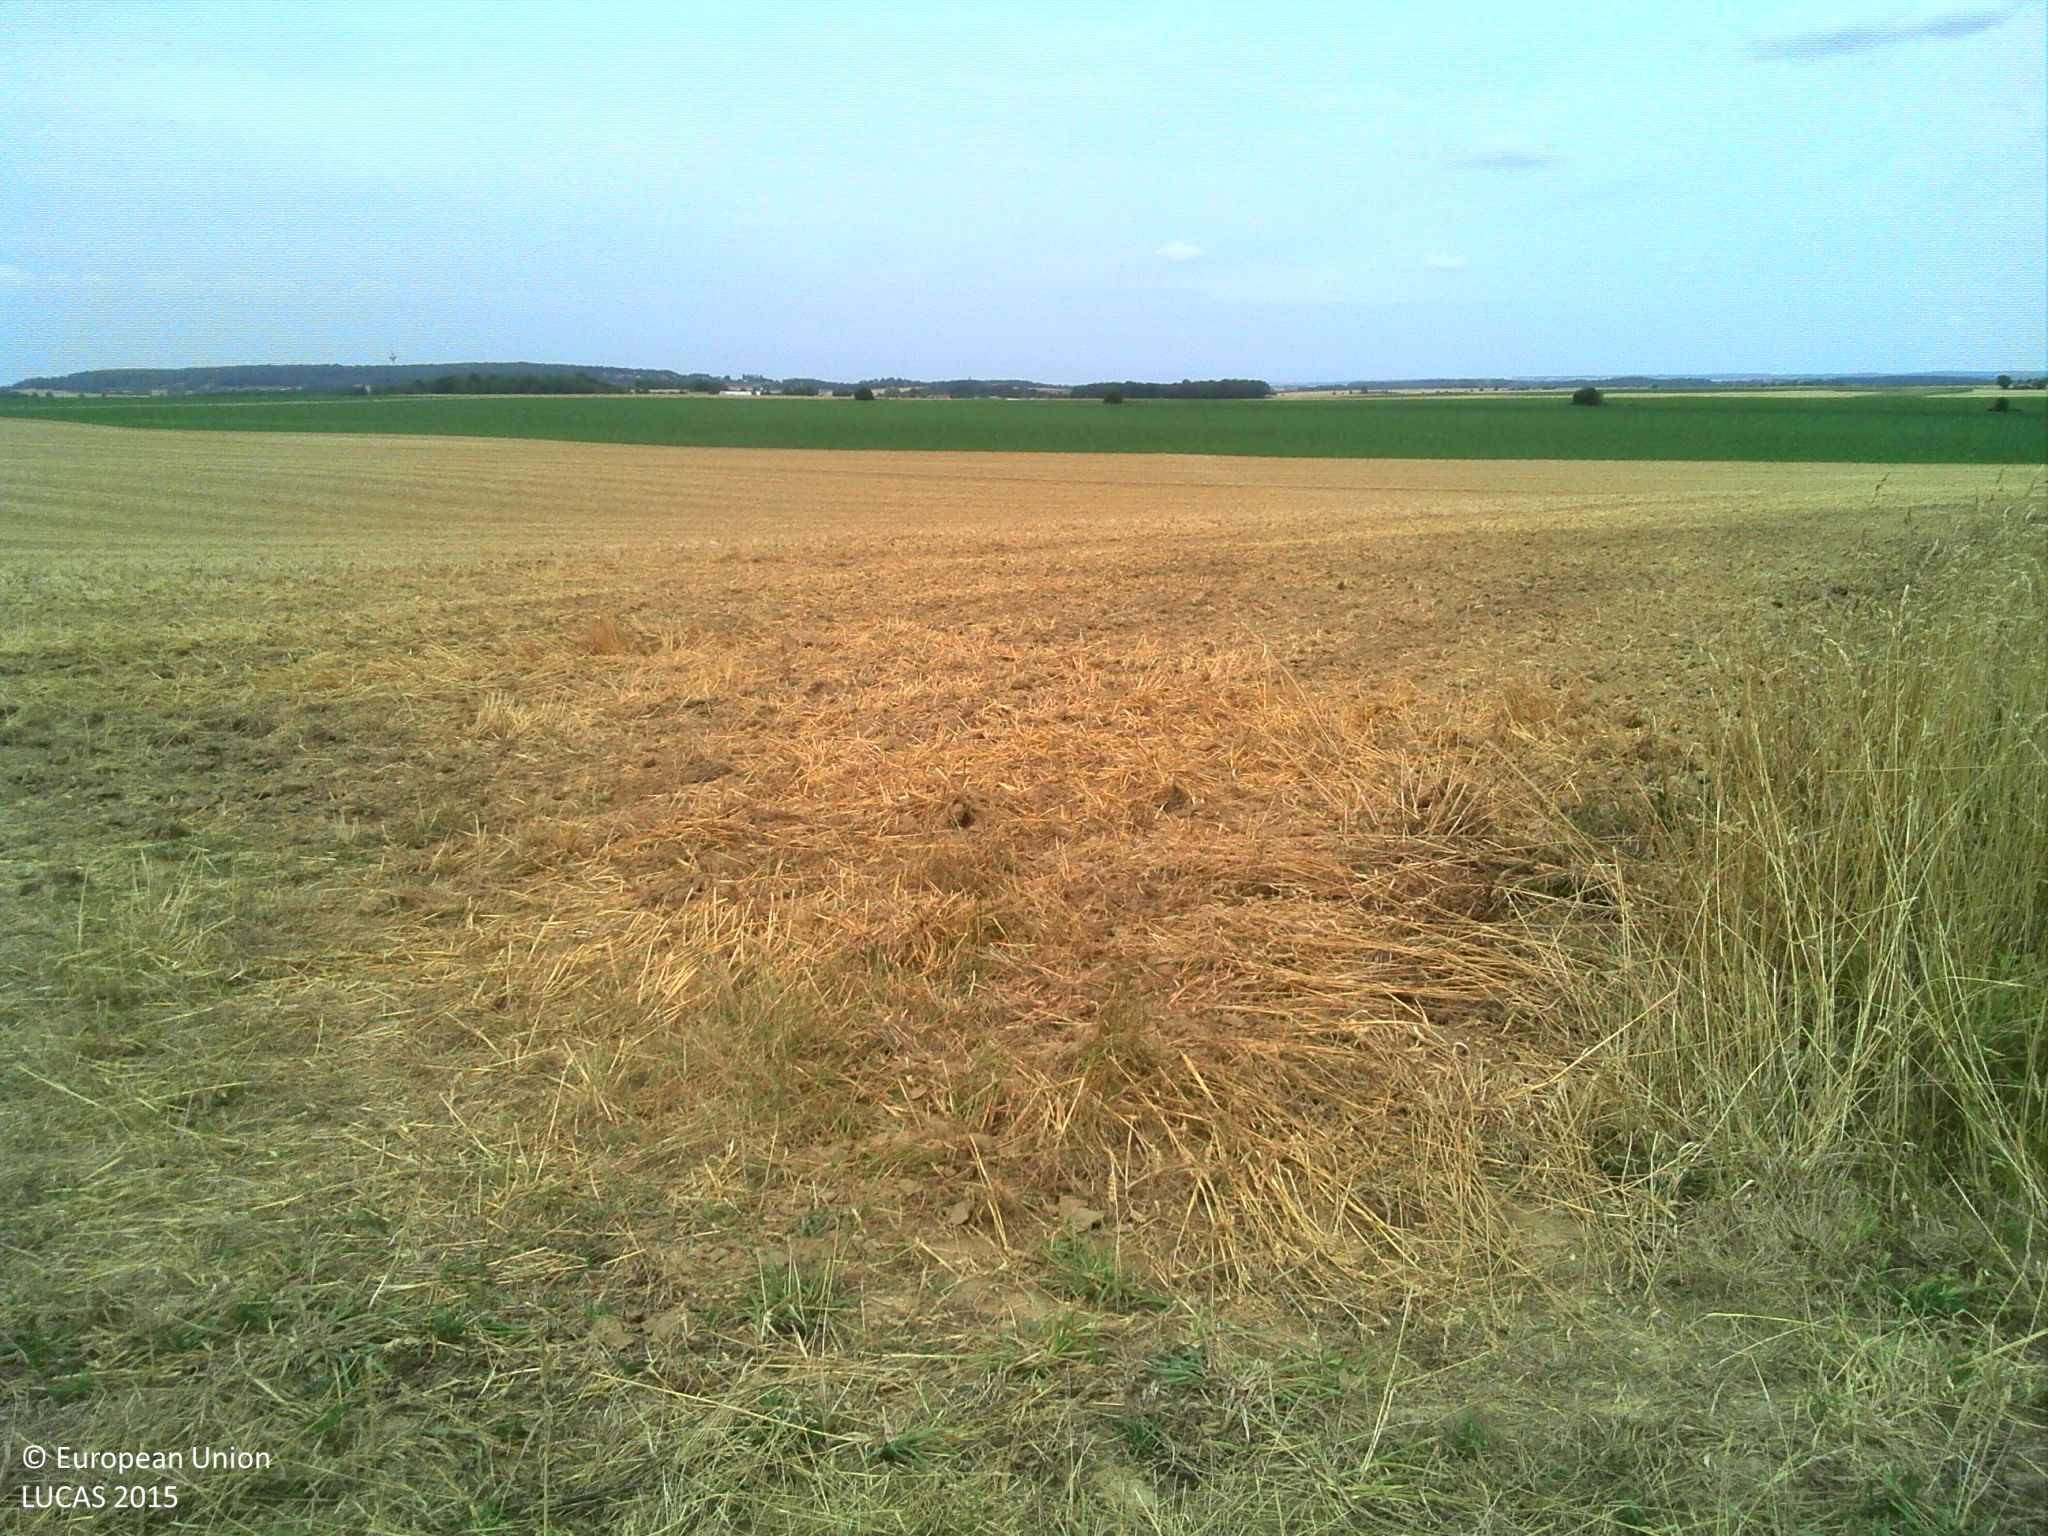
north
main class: Grassland
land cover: Grassland without tree/shrub cover
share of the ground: > 75 %
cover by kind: herbaceous plants 100 %
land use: Semi-natural and natural areas not in use
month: August
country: FR
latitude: 49.1334
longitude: 1.8571
